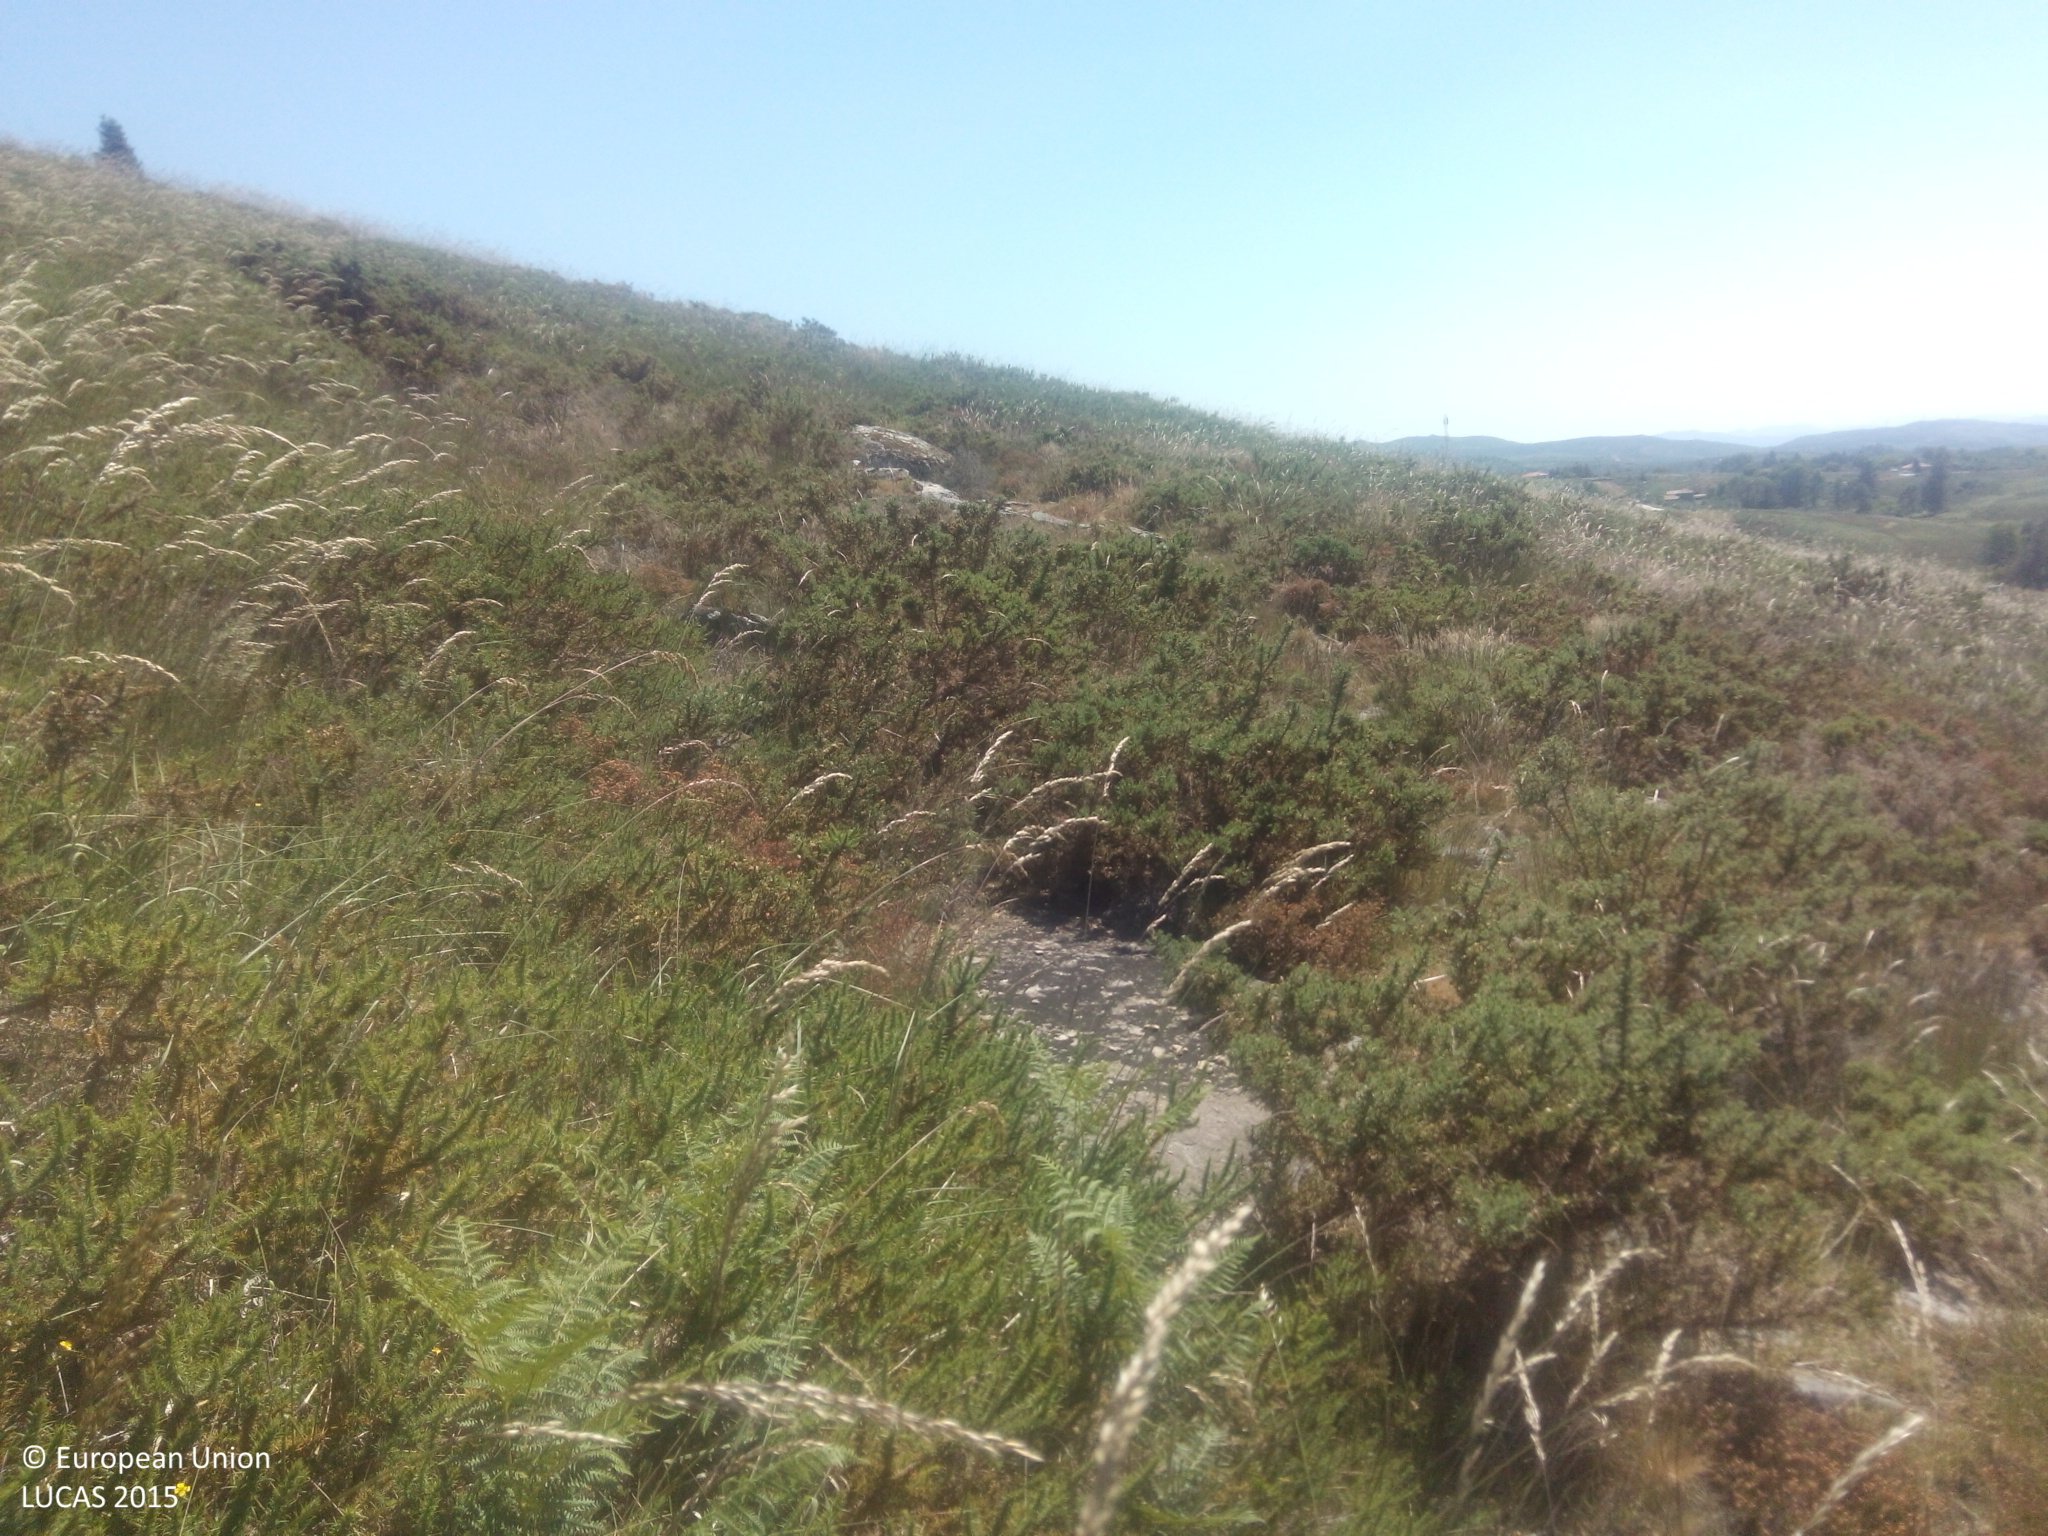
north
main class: Shrubland
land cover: Shrubland without tree cover
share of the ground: > 75 %
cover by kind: shrubs 100 %
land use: Semi-natural and natural areas not in use
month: June
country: ES
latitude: 42.4575
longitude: -8.3455
